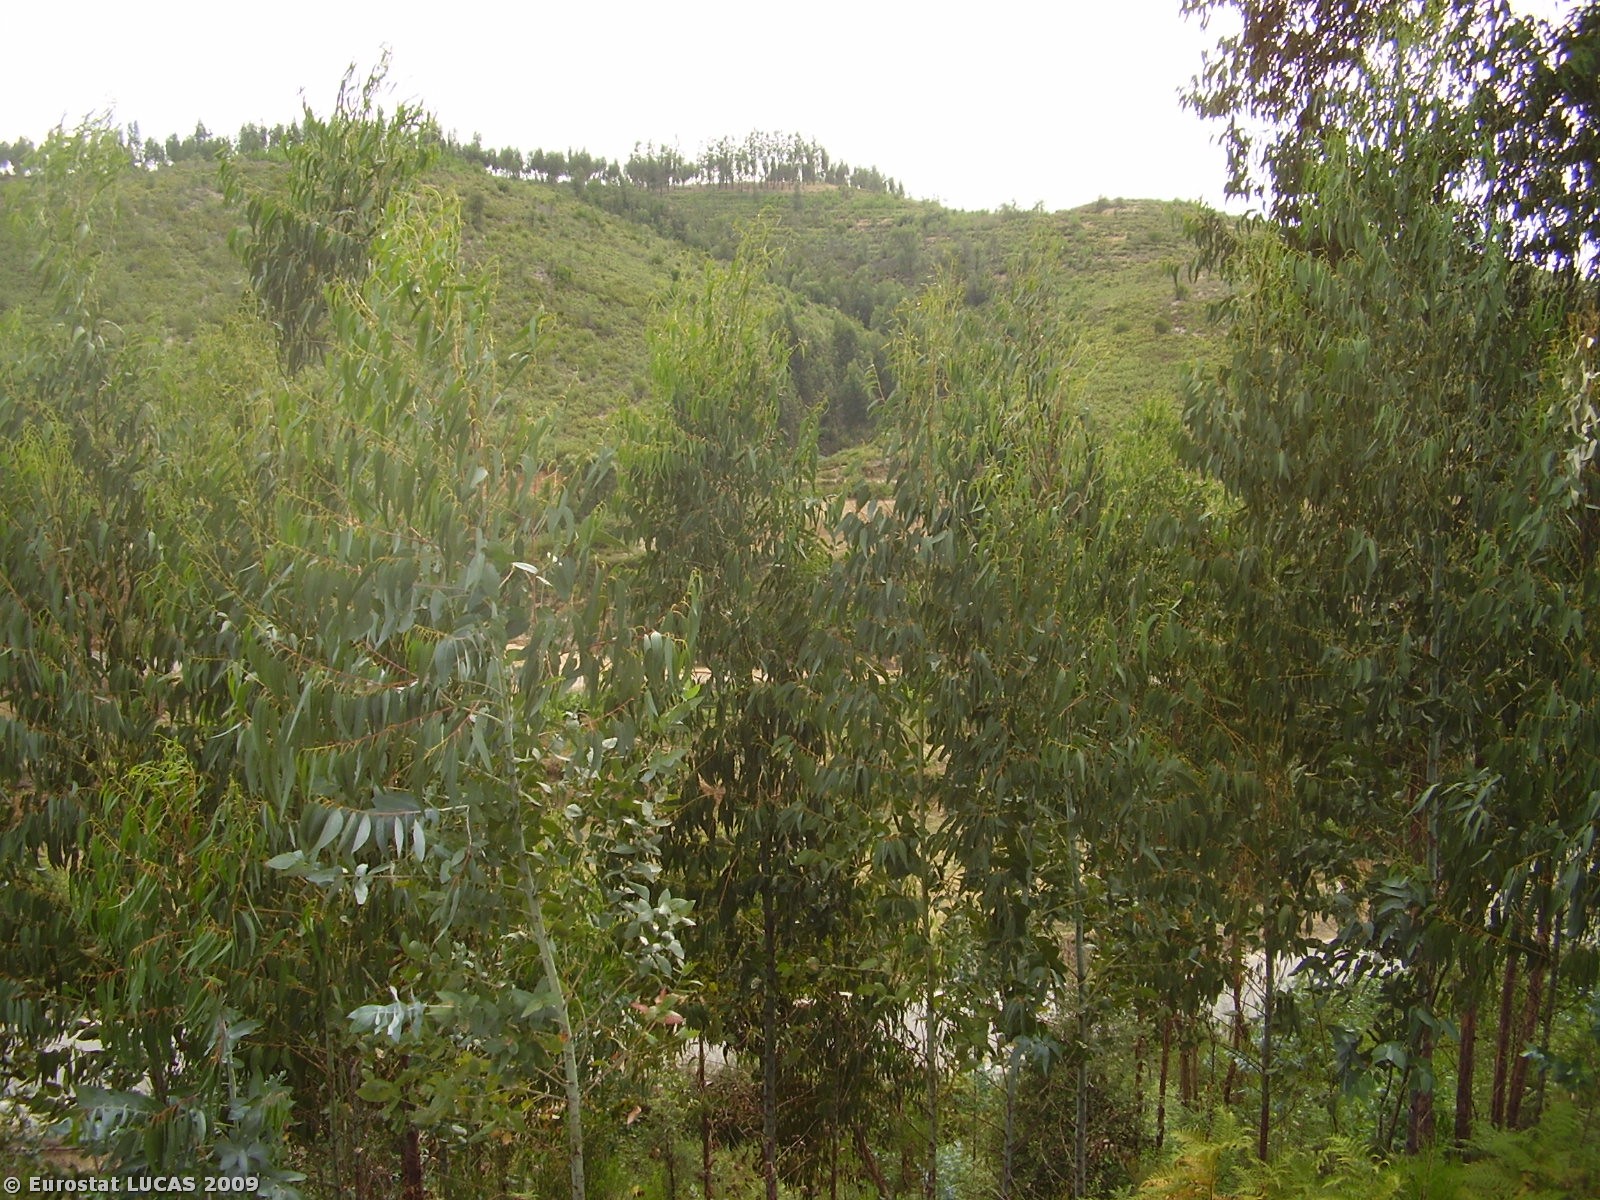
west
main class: Woodland
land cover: Coniferous woodland
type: coniferous forest of the mediterranean region
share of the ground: 50 - 75 %
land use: Forestry
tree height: > 5 m
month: July
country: PT
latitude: 39.5197
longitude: -8.2473
